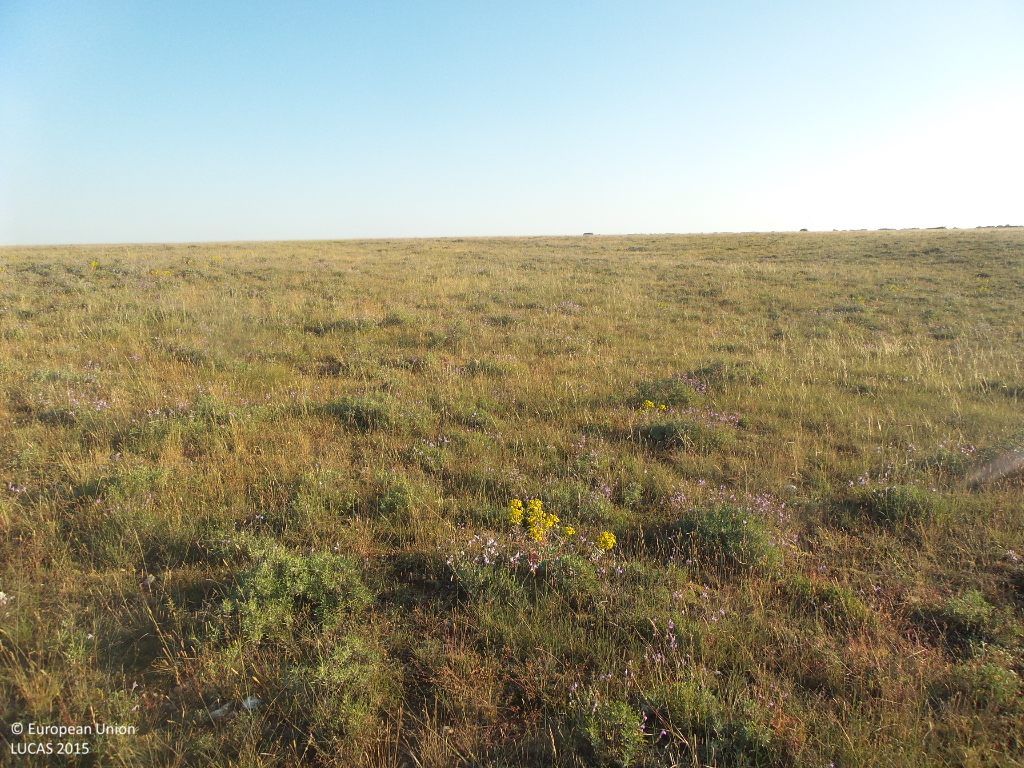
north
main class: Shrubland
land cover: Shrubland without tree cover
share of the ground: 25 - 50 %
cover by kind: shrubs 40 %, herbaceous plants 40 %, unconsolidated bare surface 20 %
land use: Semi-natural and natural areas not in use
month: June
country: ES
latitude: 41.3377
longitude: -2.7149
